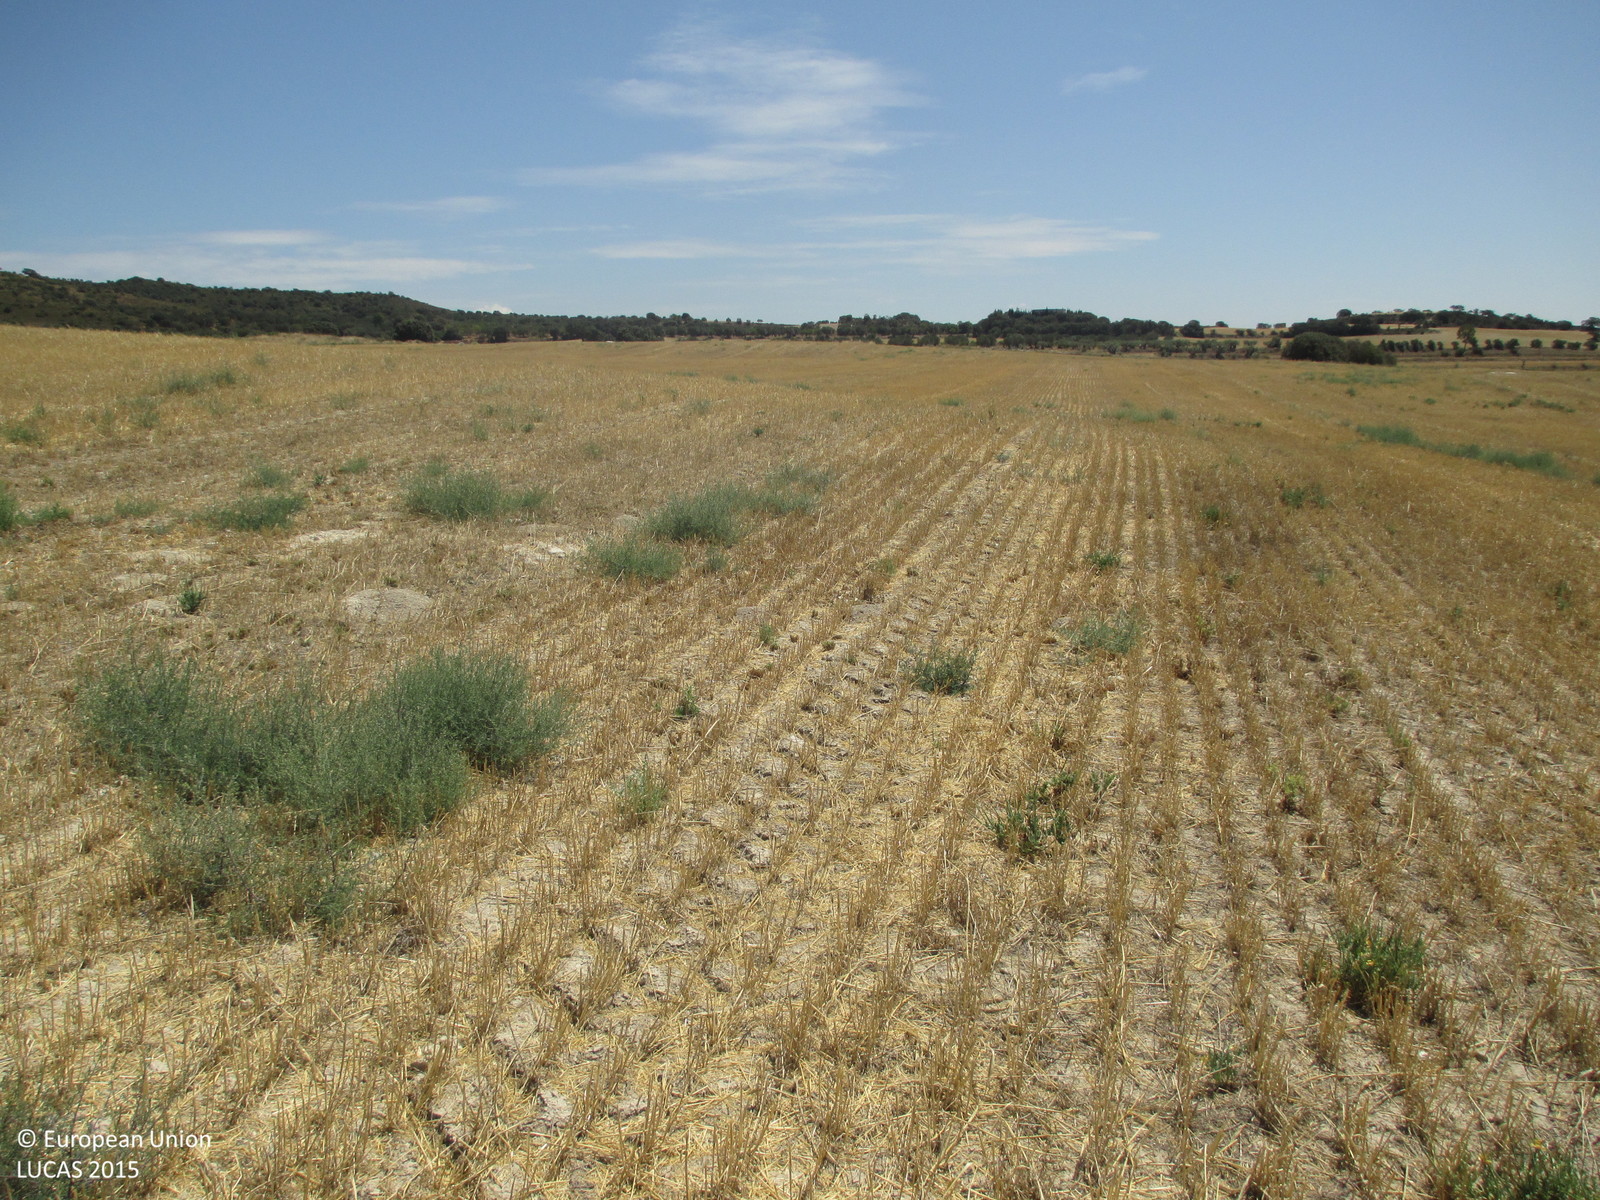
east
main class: Cropland
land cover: Barley
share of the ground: < 10 %
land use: Agriculture (excluding fallow land and kitchen gardens)
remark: Harvested field
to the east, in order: Barley; Tracks; Grass margins; Barley; Grass margins; Barley; Tracks; Barley
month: July
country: ES
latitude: 41.9866
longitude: 0.2907
